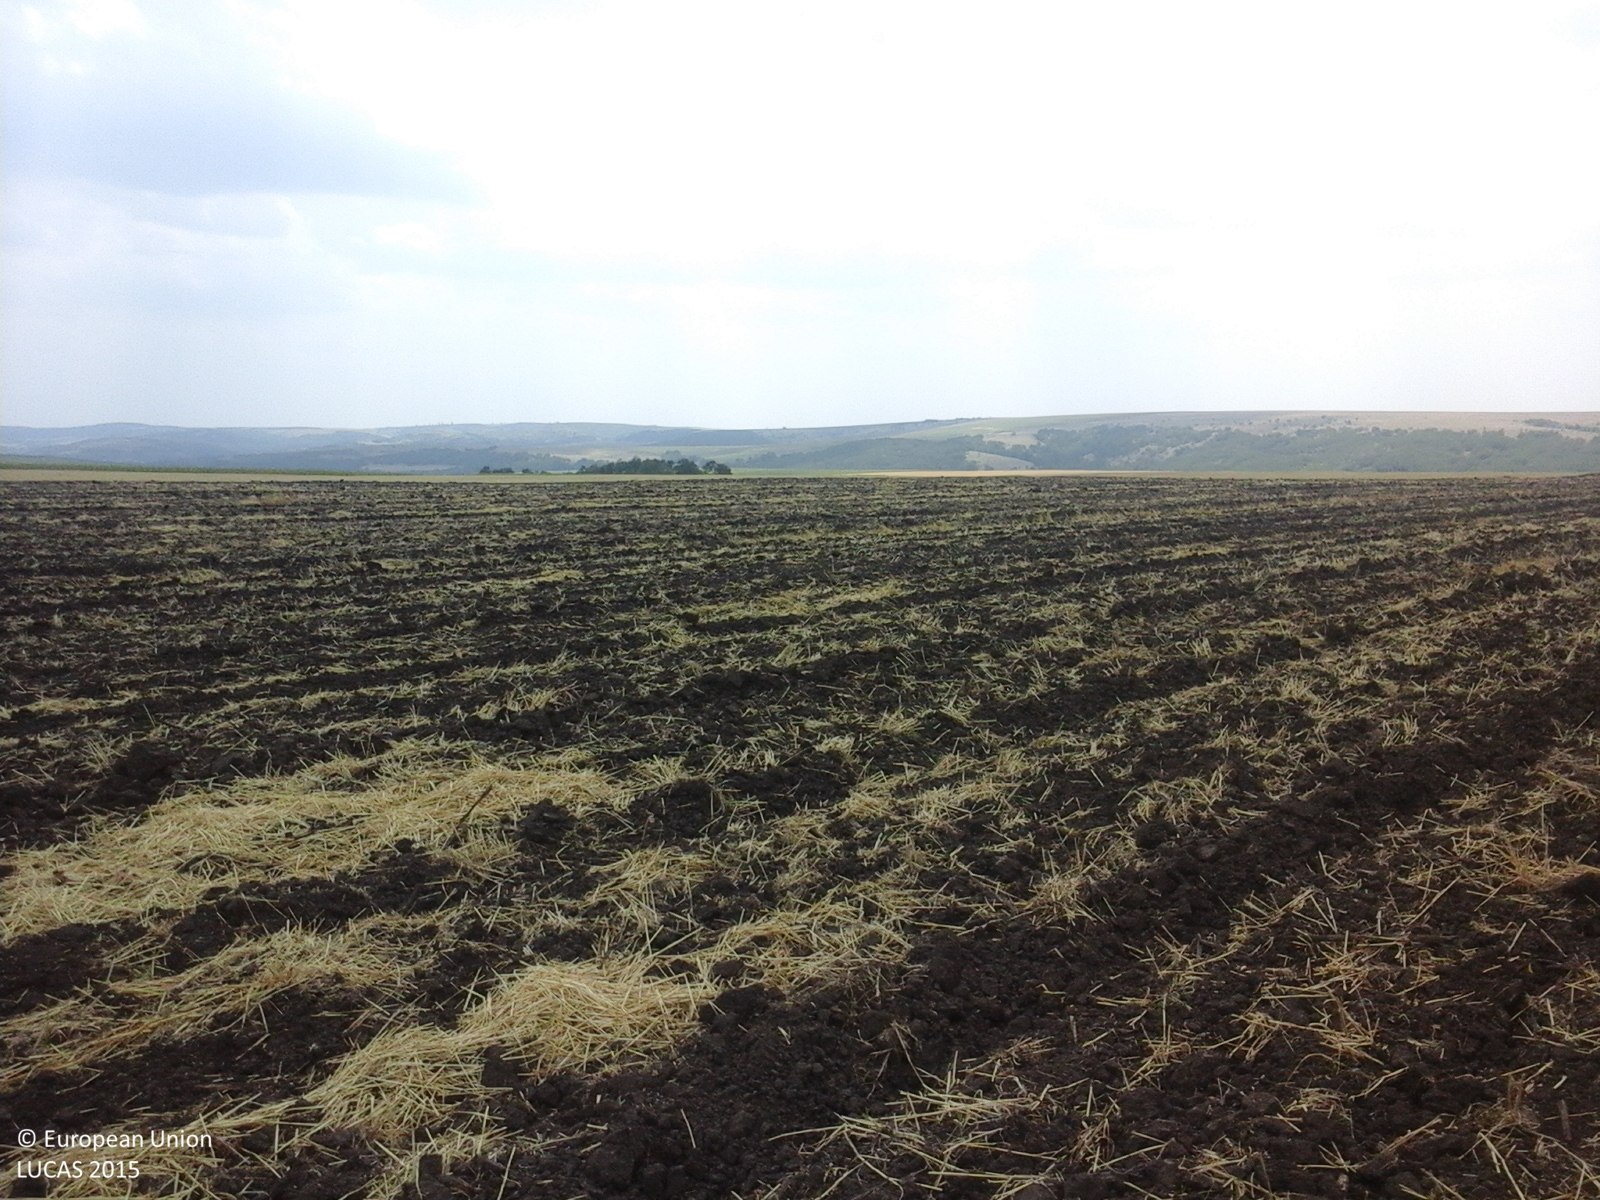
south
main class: Cropland
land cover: Common wheat
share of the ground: 10 - 25 %
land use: Agriculture (excluding fallow land and kitchen gardens)
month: July
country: RO
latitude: 46.0614
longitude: 28.0004
